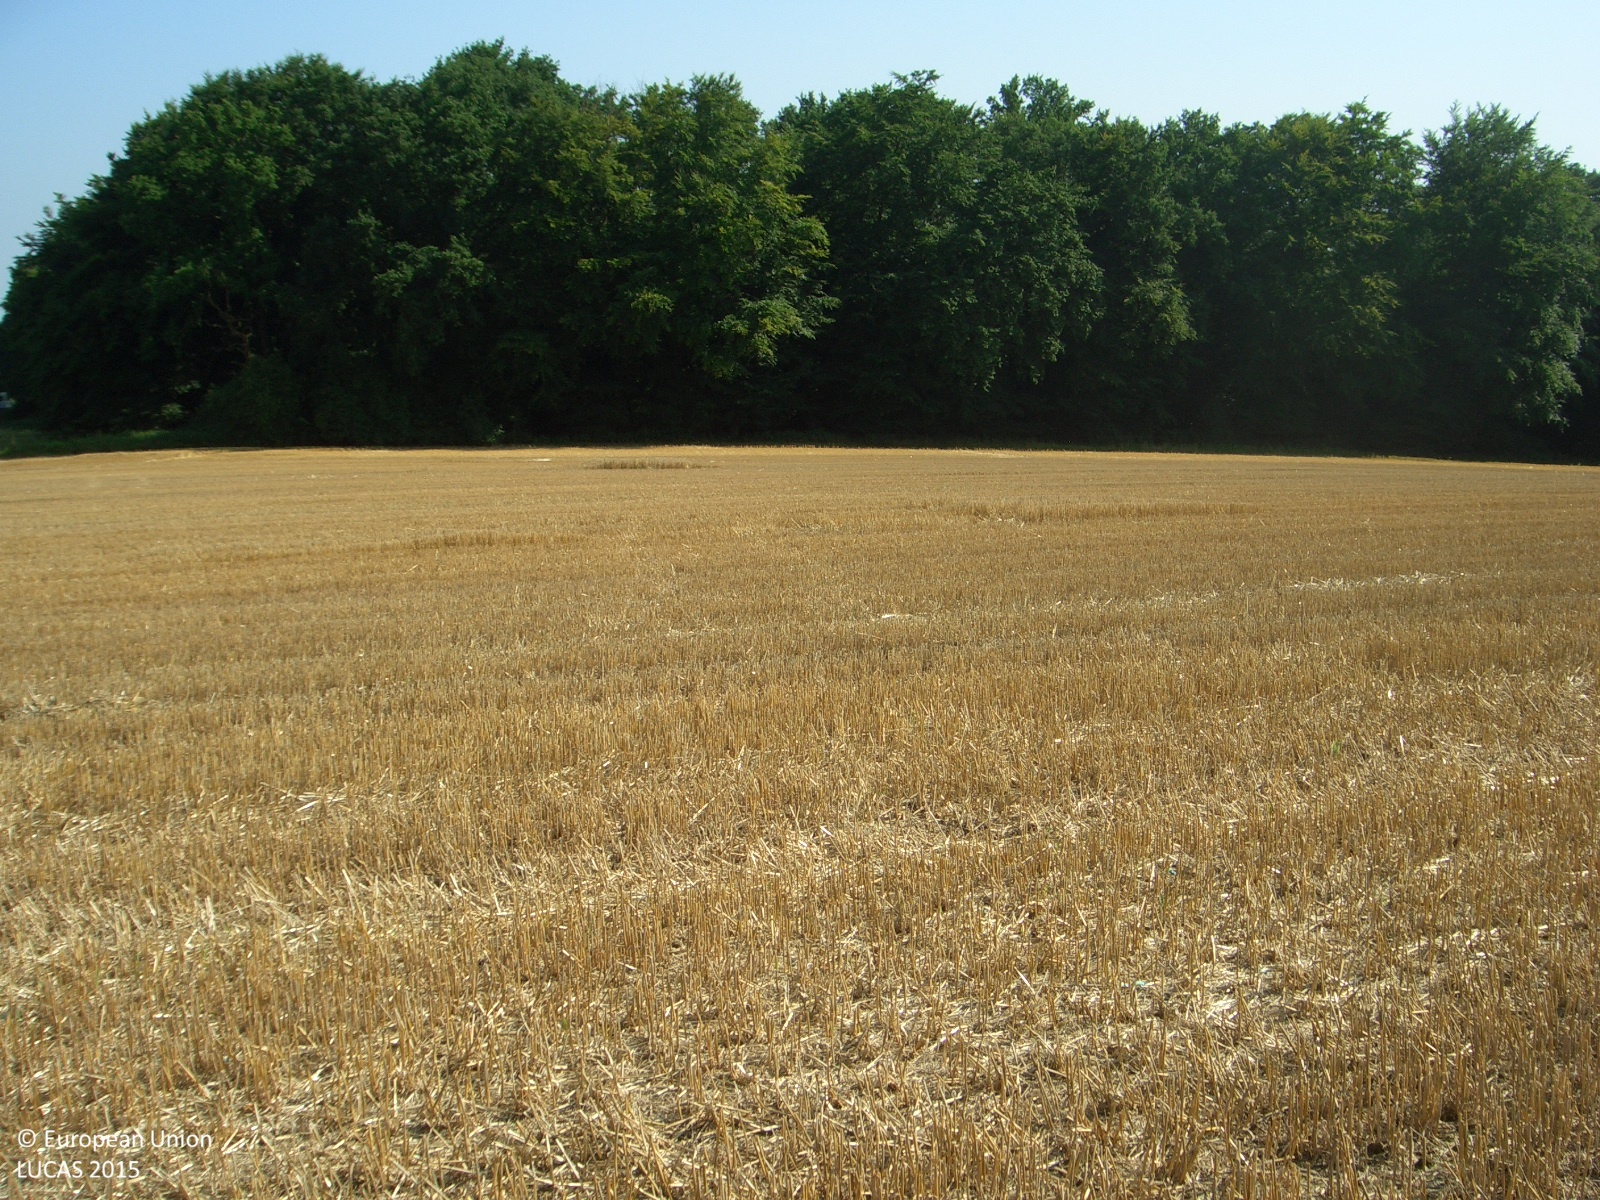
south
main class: Cropland
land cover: Barley
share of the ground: 25 - 50 %
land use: Agriculture (excluding fallow land and kitchen gardens)
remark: Harvested field
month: July
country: DE
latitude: 51.4034
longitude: 6.9668
